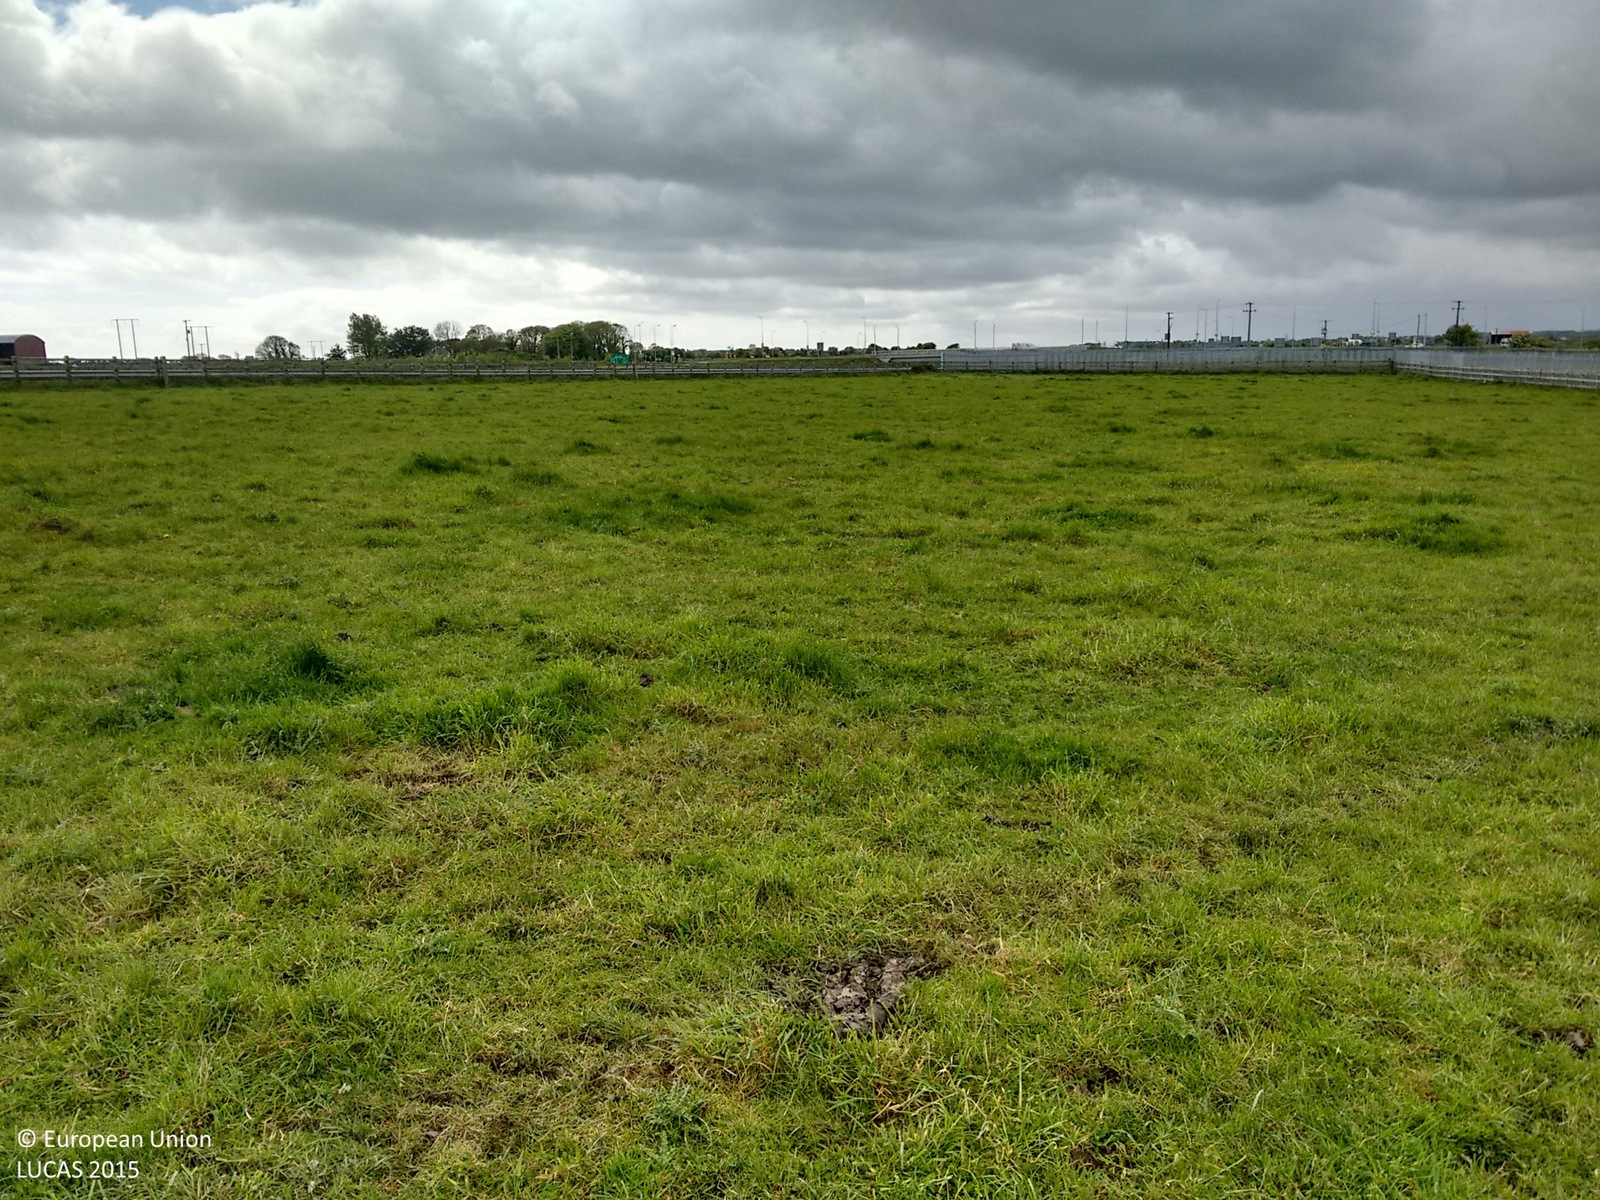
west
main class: Grassland
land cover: Grassland without tree/shrub cover
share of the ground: > 75 %
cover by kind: herbaceous plants 95 %, consolidated bare surface 5 %
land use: Agriculture (excluding fallow land and kitchen gardens)
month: May
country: IE
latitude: 53.2961
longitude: -8.9188
